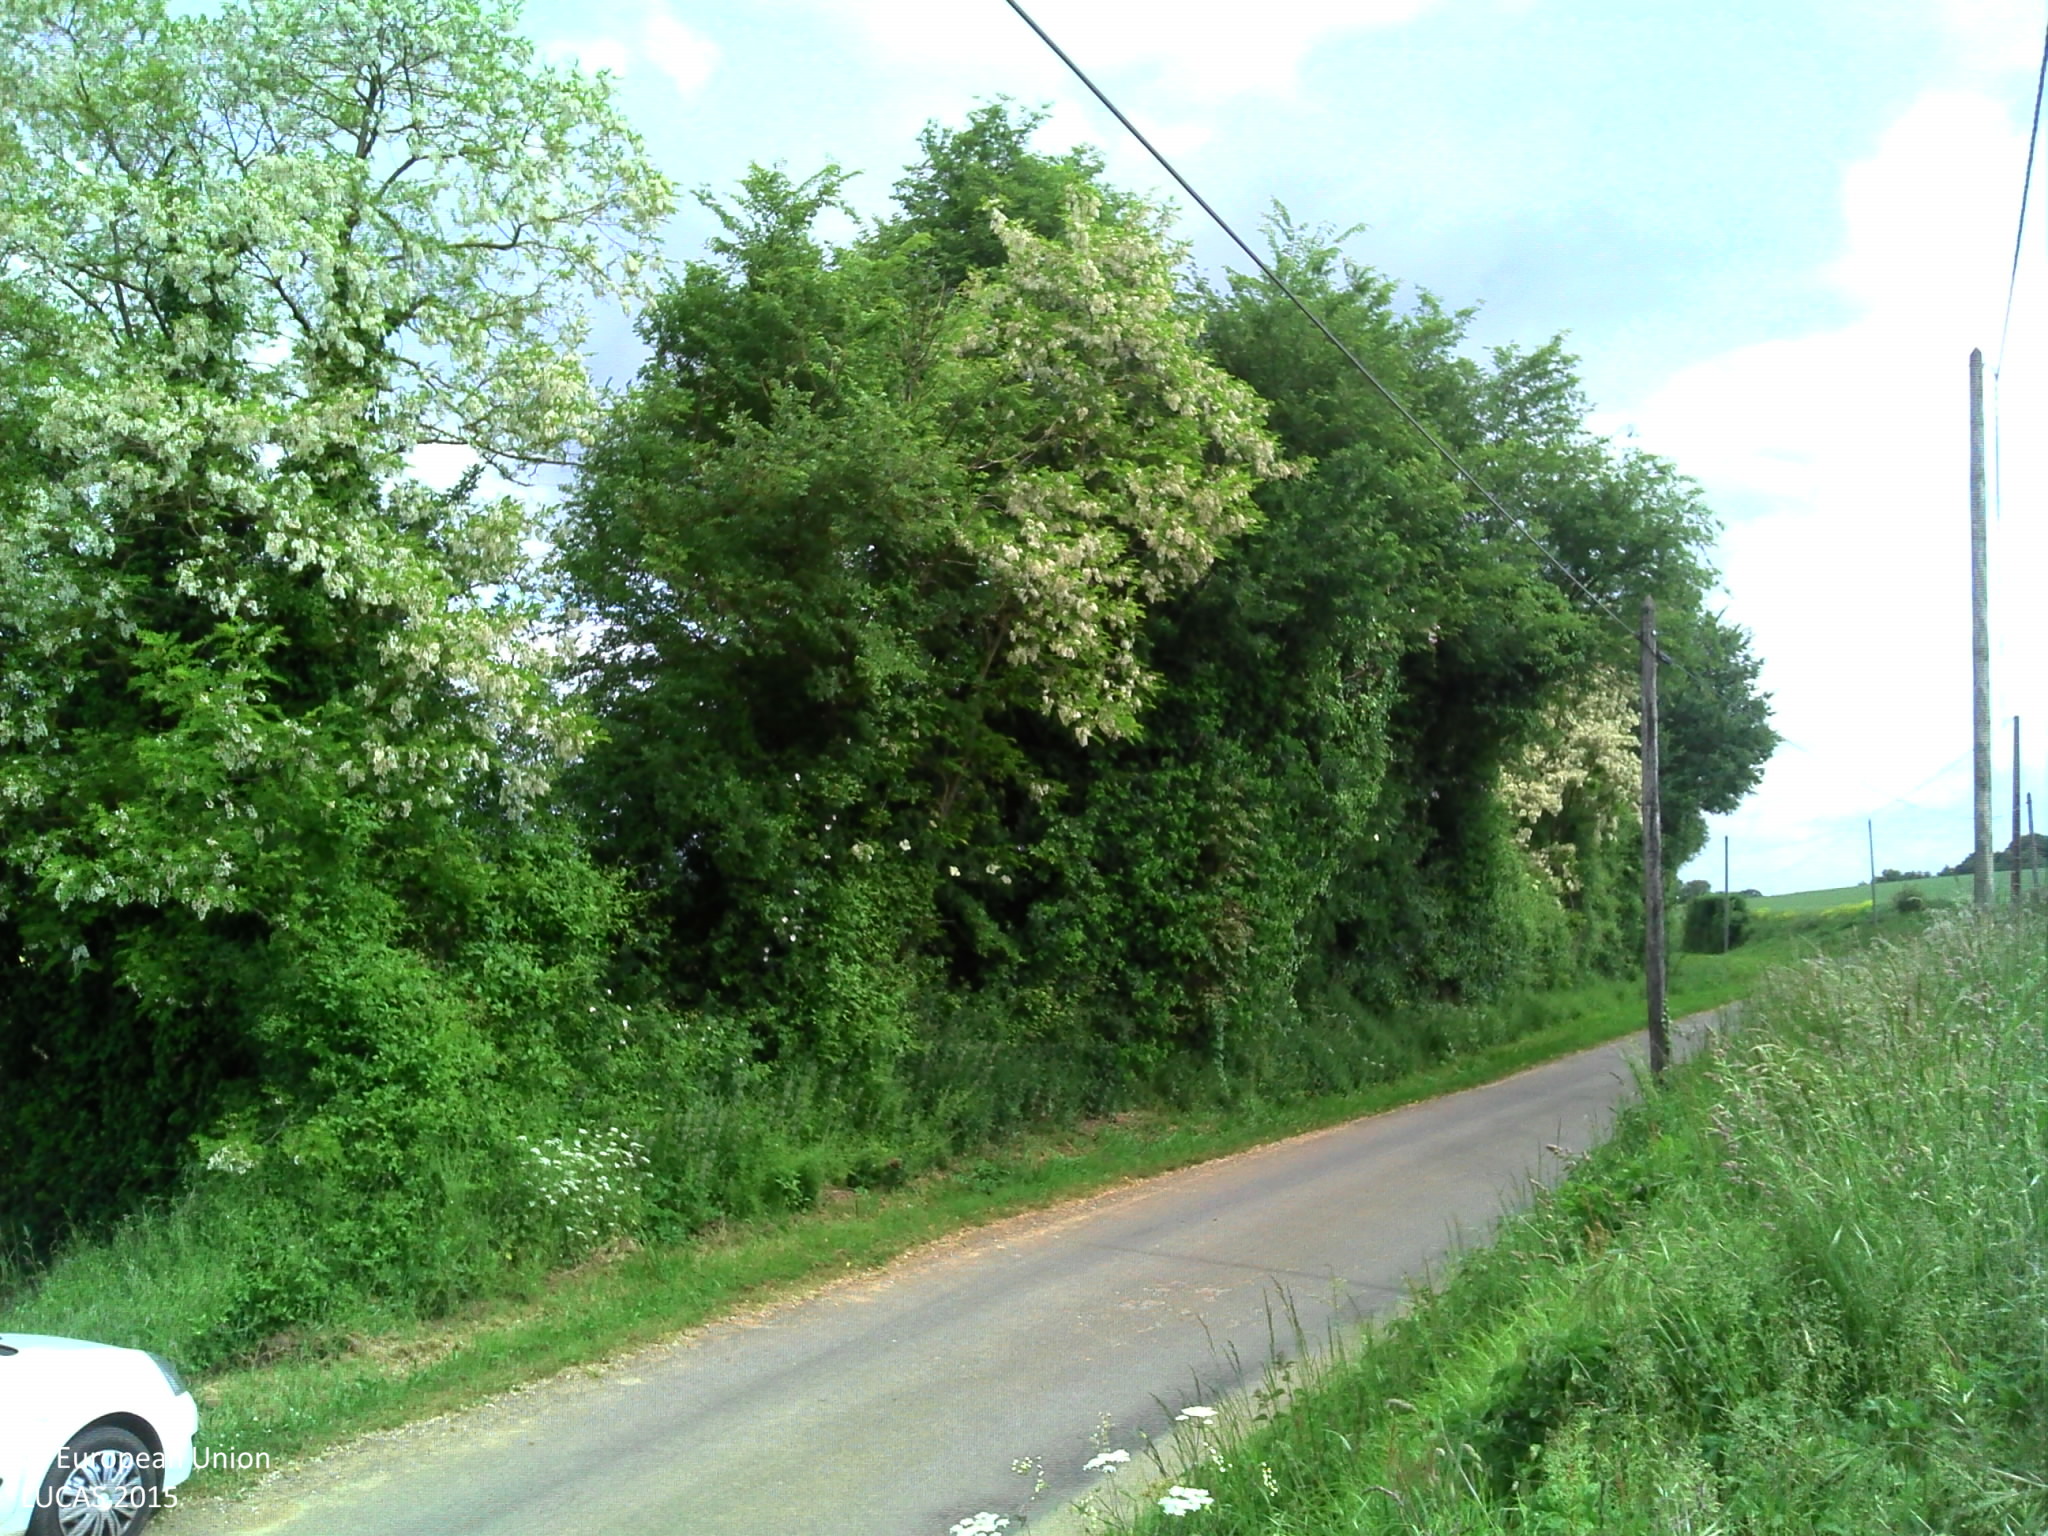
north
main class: Cropland
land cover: Common wheat
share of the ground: > 75 %
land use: Agriculture (excluding fallow land and kitchen gardens)
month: May
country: FR
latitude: 48.0532
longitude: -0.0507
